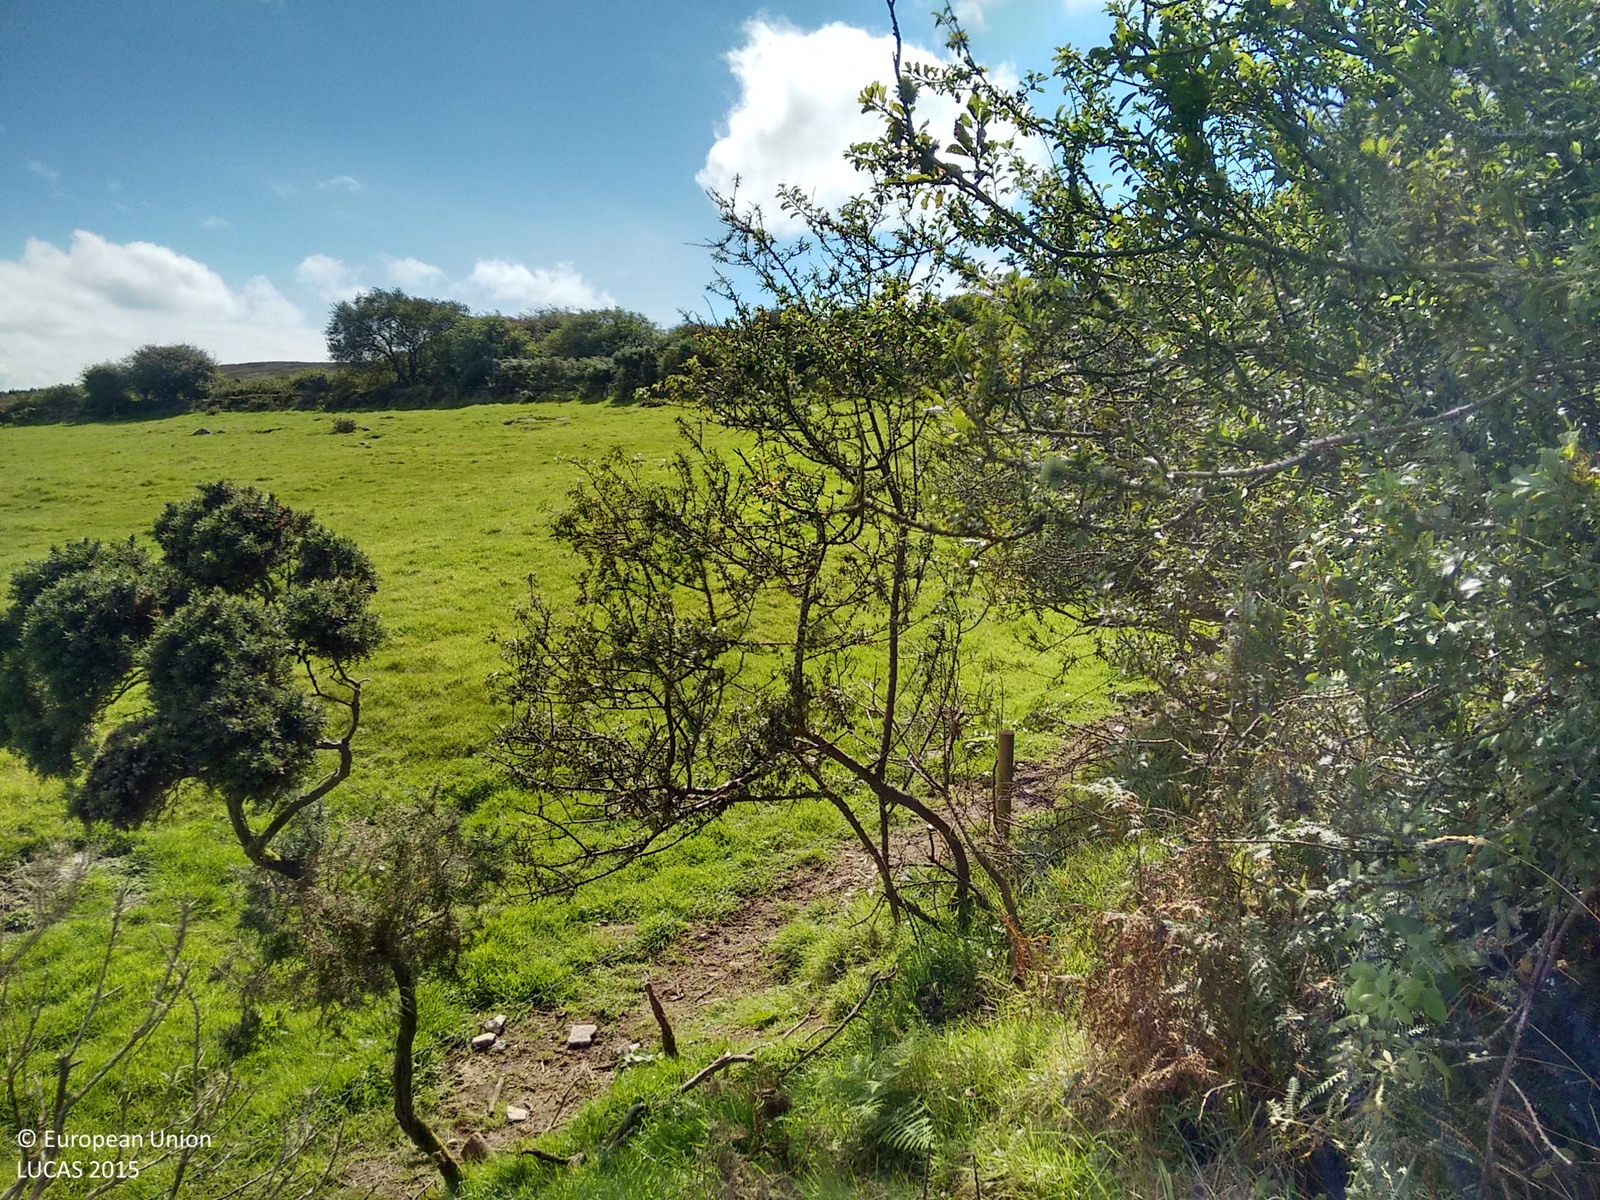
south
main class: Shrubland
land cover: Shrubland without tree cover
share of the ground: > 75 %
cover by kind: shrubs 70 %, herbaceous plants 30 %
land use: Agriculture (excluding fallow land and kitchen gardens)
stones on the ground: < 10 %
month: September
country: GB
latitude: 50.1244
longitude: -5.3562
